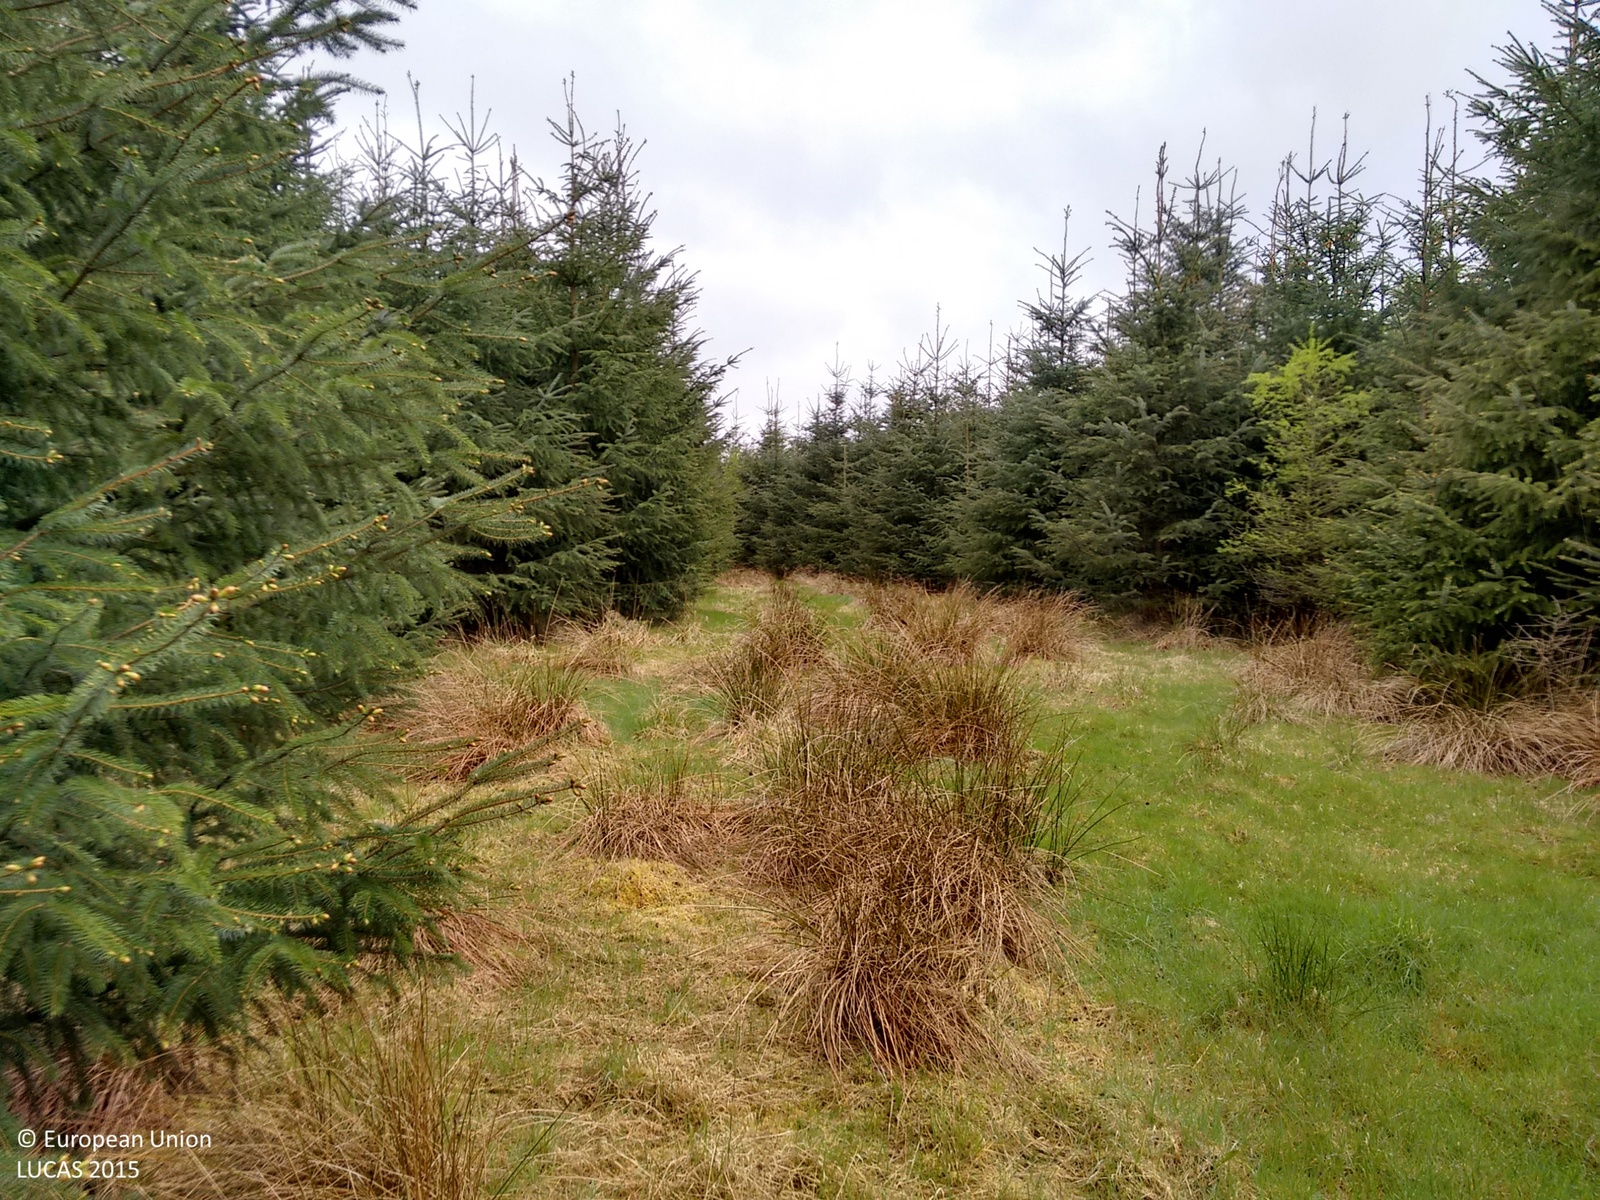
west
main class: Woodland
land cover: Spruce dominated coniferous woodland
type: hemiboreal forest and nemoral coniferous forest and mixed broadleaved-coniferous forest
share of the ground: > 75 %
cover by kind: coniferous forest trees 100 %
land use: Forestry
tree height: > 5 m
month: May
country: GB
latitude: 55.9167
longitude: -3.9263
